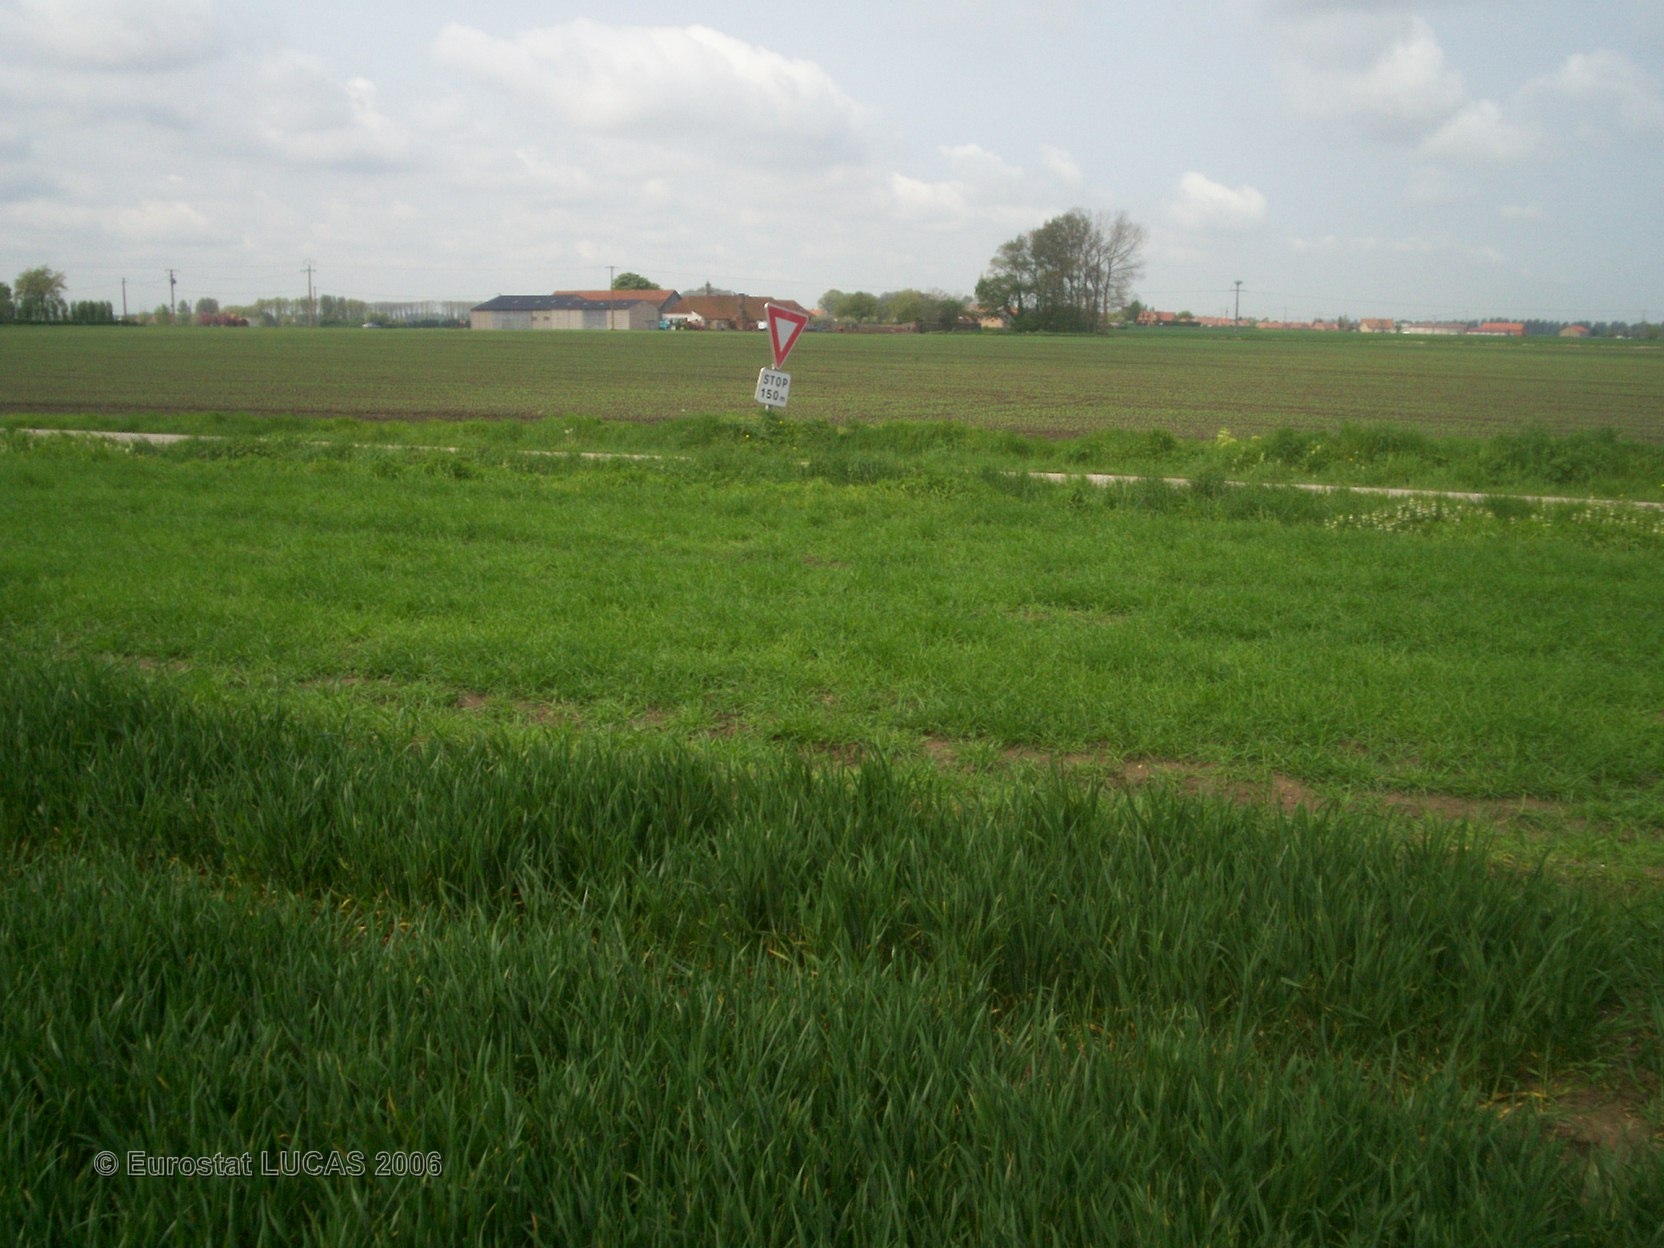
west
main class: Cropland
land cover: Common wheat
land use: Agriculture (excluding fallow land and kitchen gardens)
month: May
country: FR
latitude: 50.9165
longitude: 2.2907
